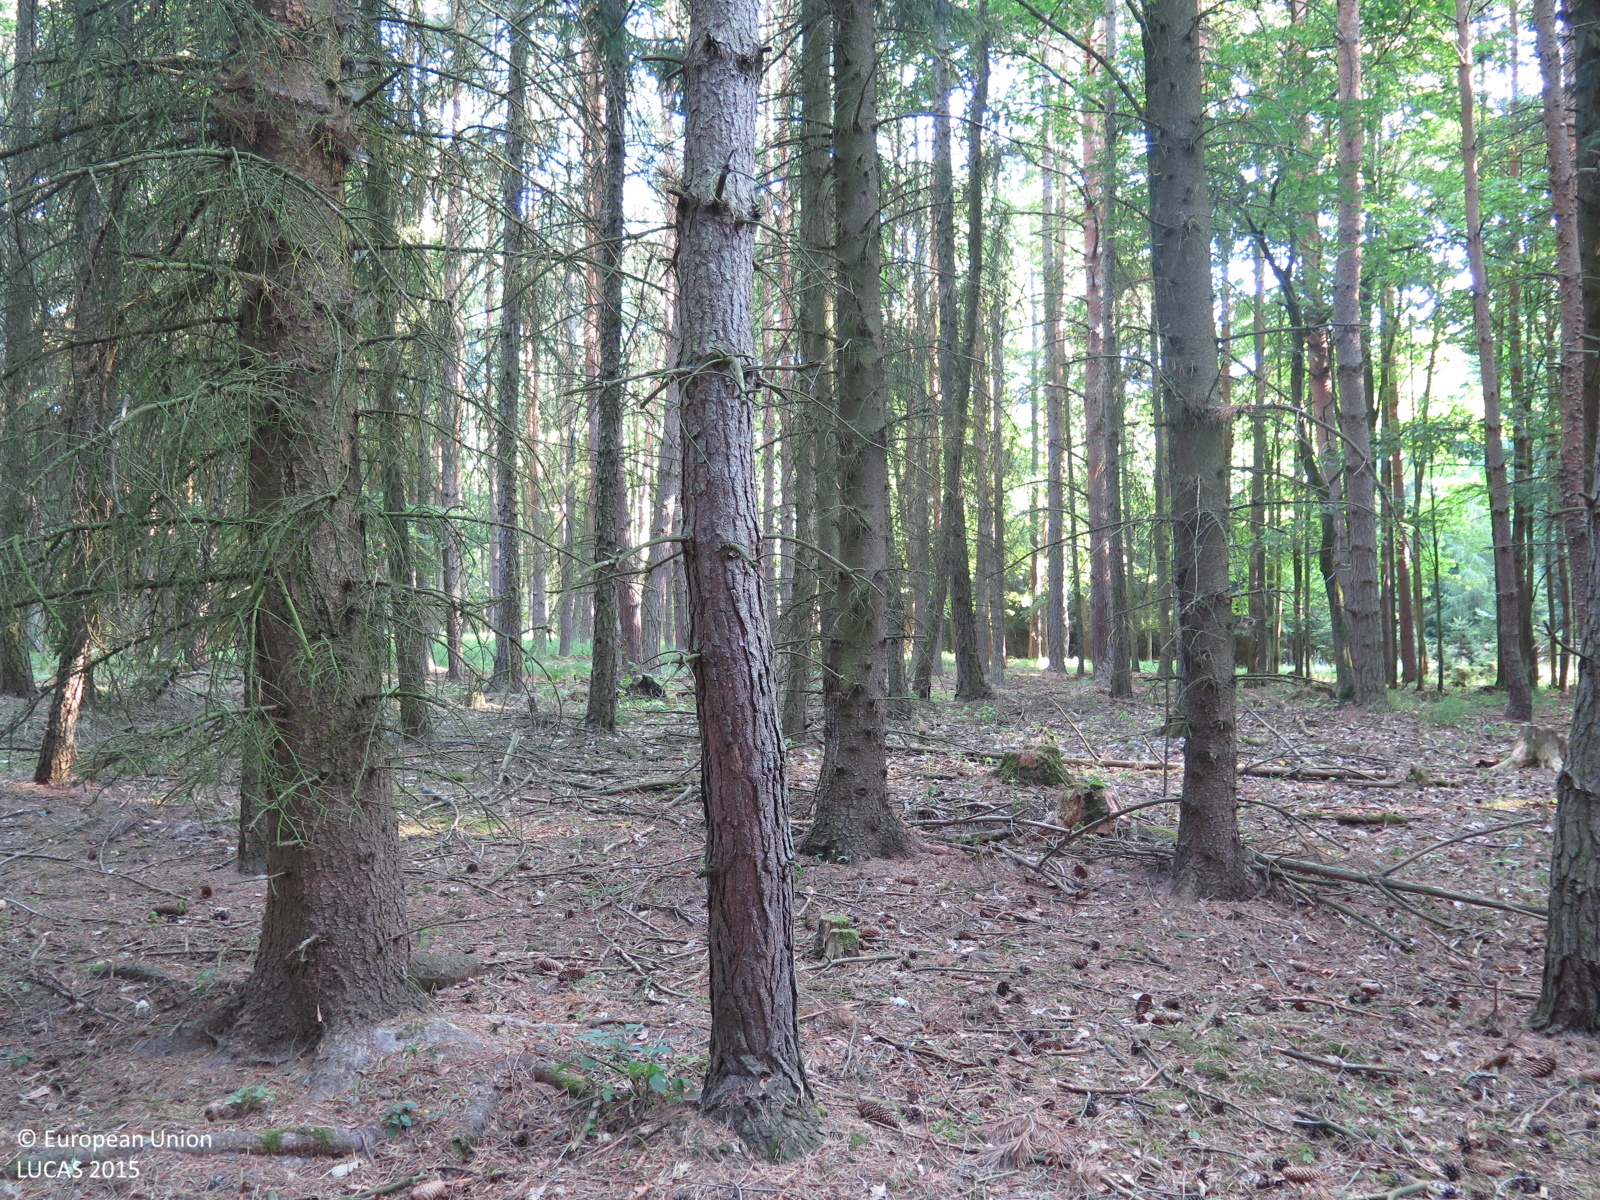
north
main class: Woodland
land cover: Other coniferous woodland
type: hemiboreal forest and nemoral coniferous forest and mixed broadleaved-coniferous forest
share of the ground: > 75 %
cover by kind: coniferous forest trees 90 %, broadleaved forest trees 5 %, herbaceous plants 5 %
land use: Forestry
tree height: > 5 m
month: August
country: CZ
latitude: 50.0835
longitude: 13.8439
